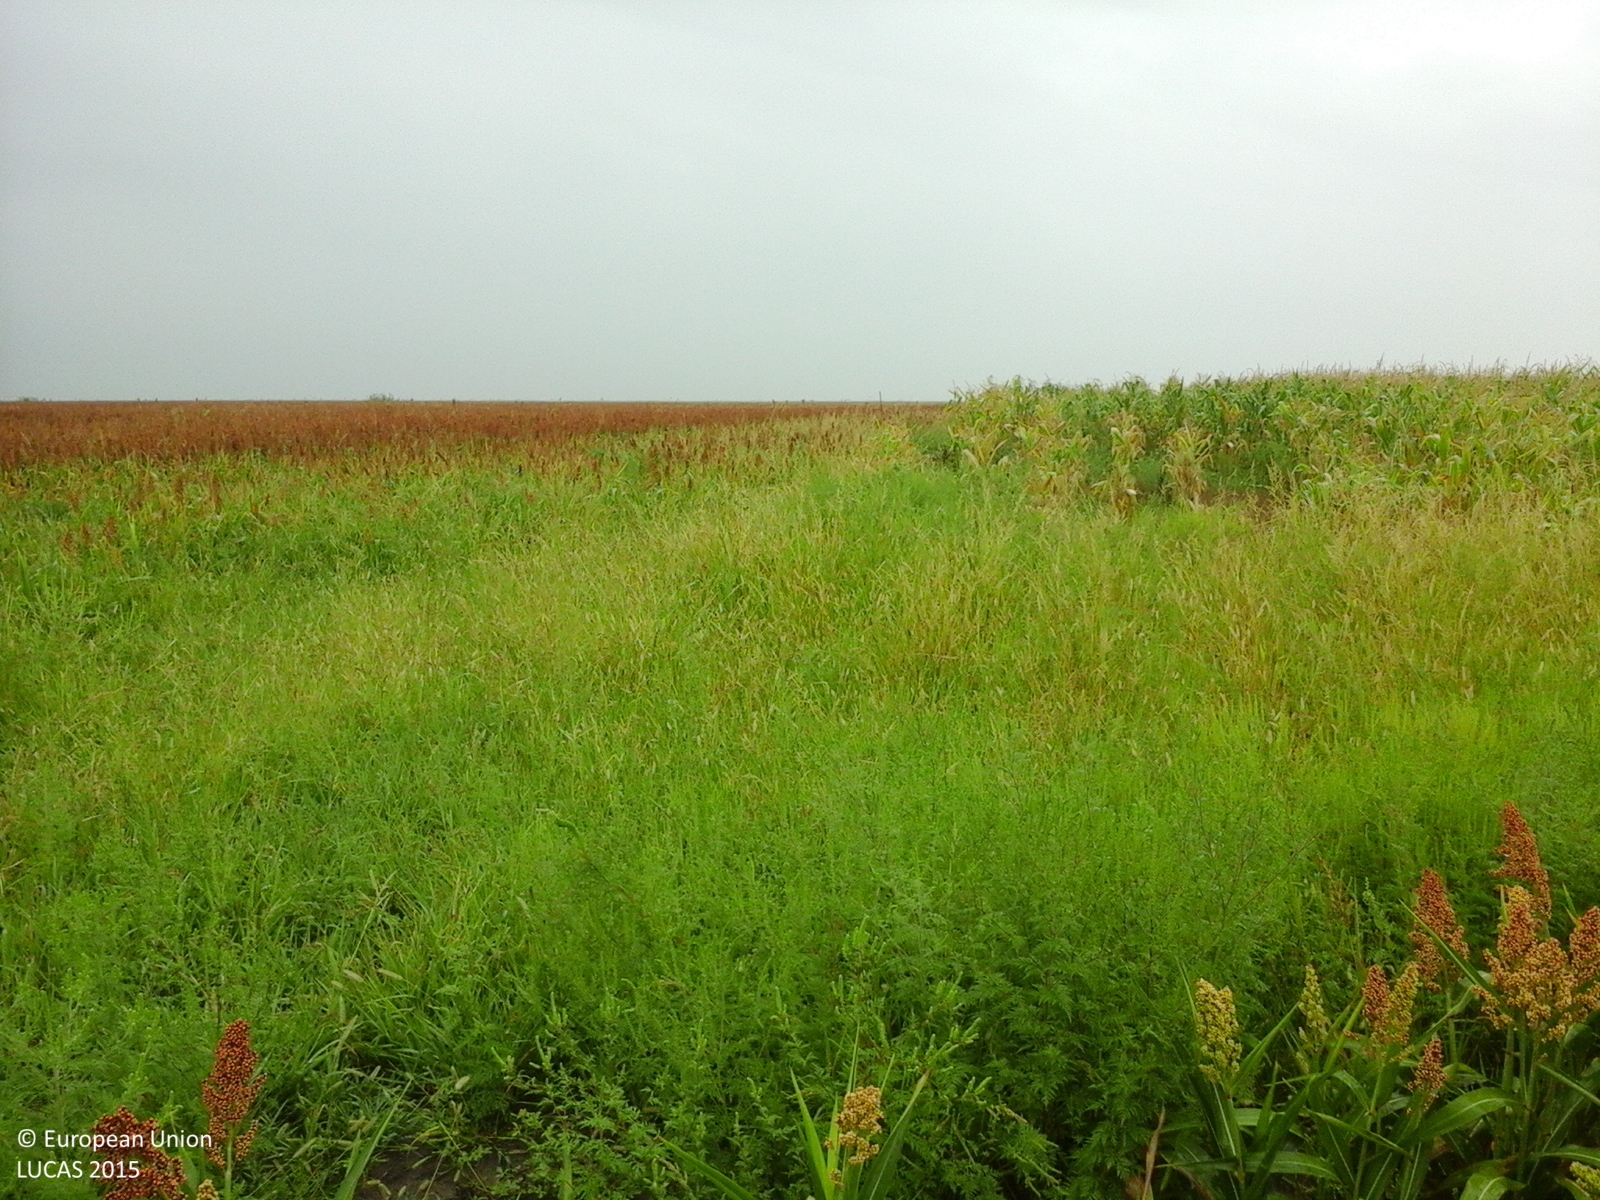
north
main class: Cropland
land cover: Other cereals
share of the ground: > 75 %
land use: Agriculture (excluding fallow land and kitchen gardens)
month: August
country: RO
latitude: 45.4762
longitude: 21.4810
